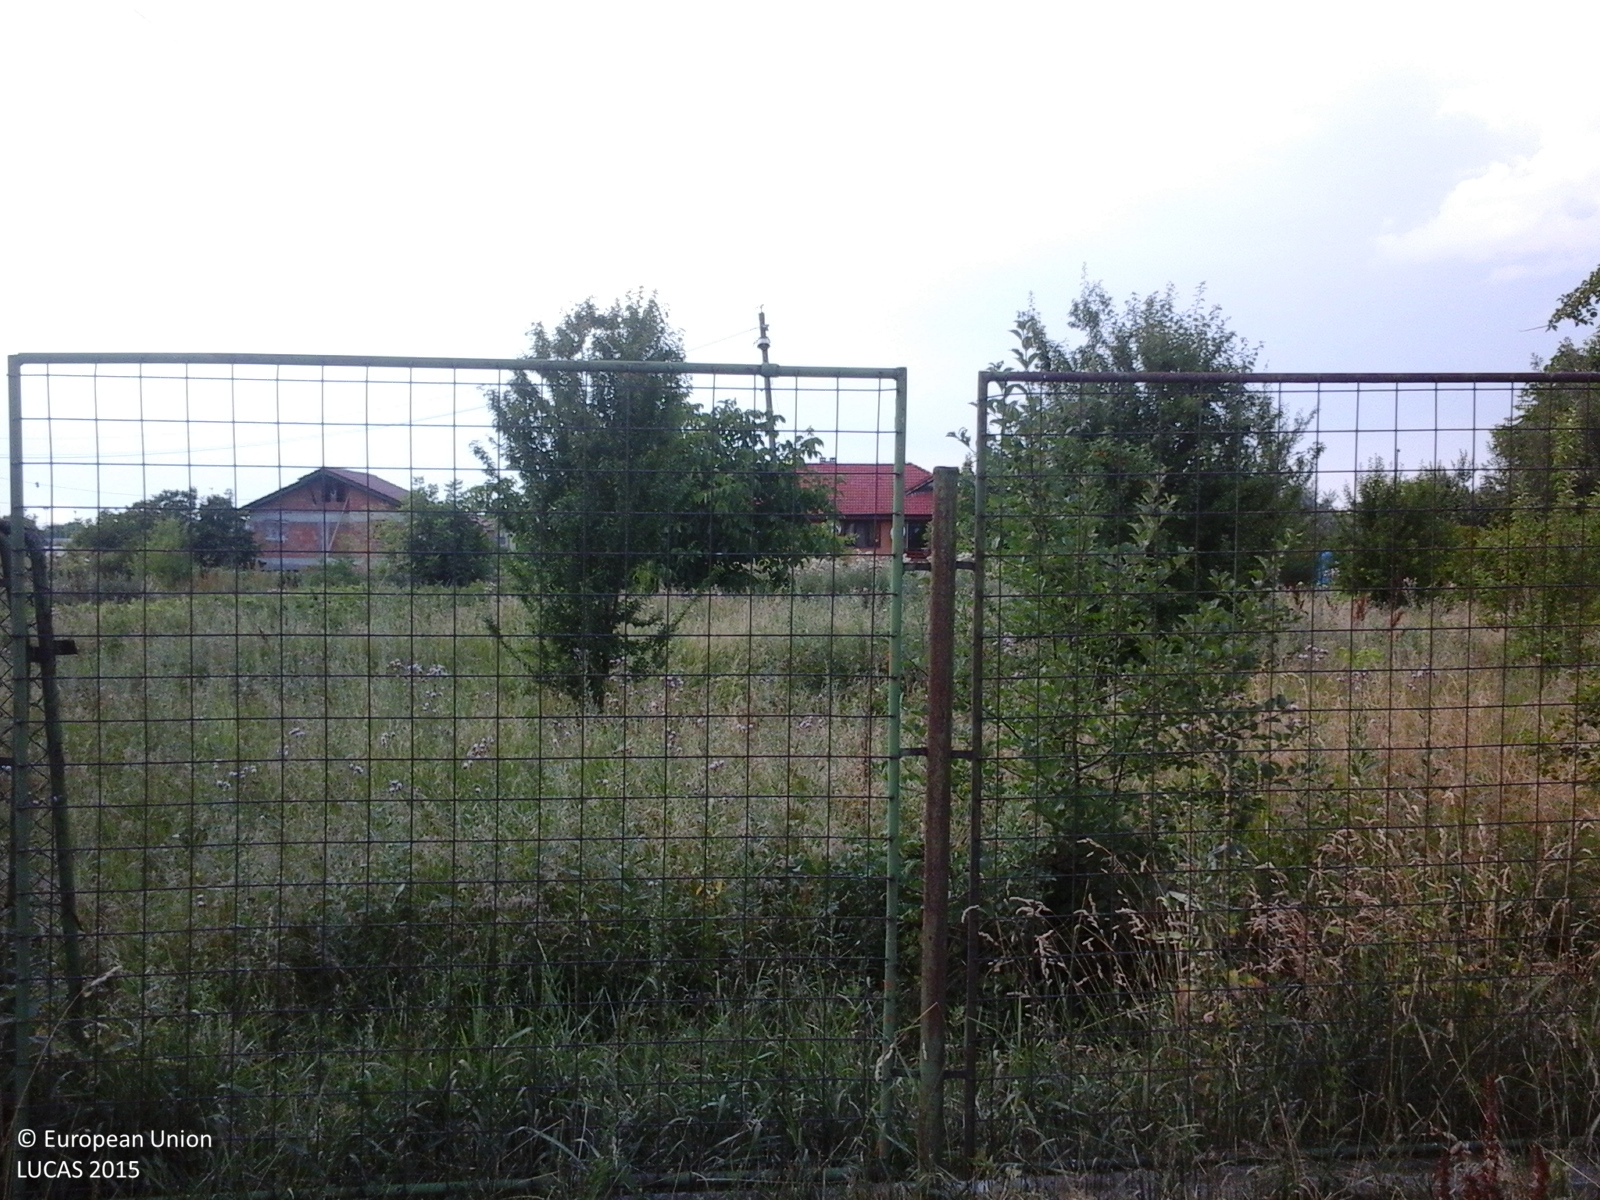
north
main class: Grassland
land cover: Grassland with sparse tree/shrub cover
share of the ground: > 75 %
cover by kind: herbaceous plants 95 %, broadleaved forest trees 5 %
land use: Agriculture (excluding fallow land and kitchen gardens)
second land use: Residential
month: June
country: RO
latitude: 44.5359
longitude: 26.2045
